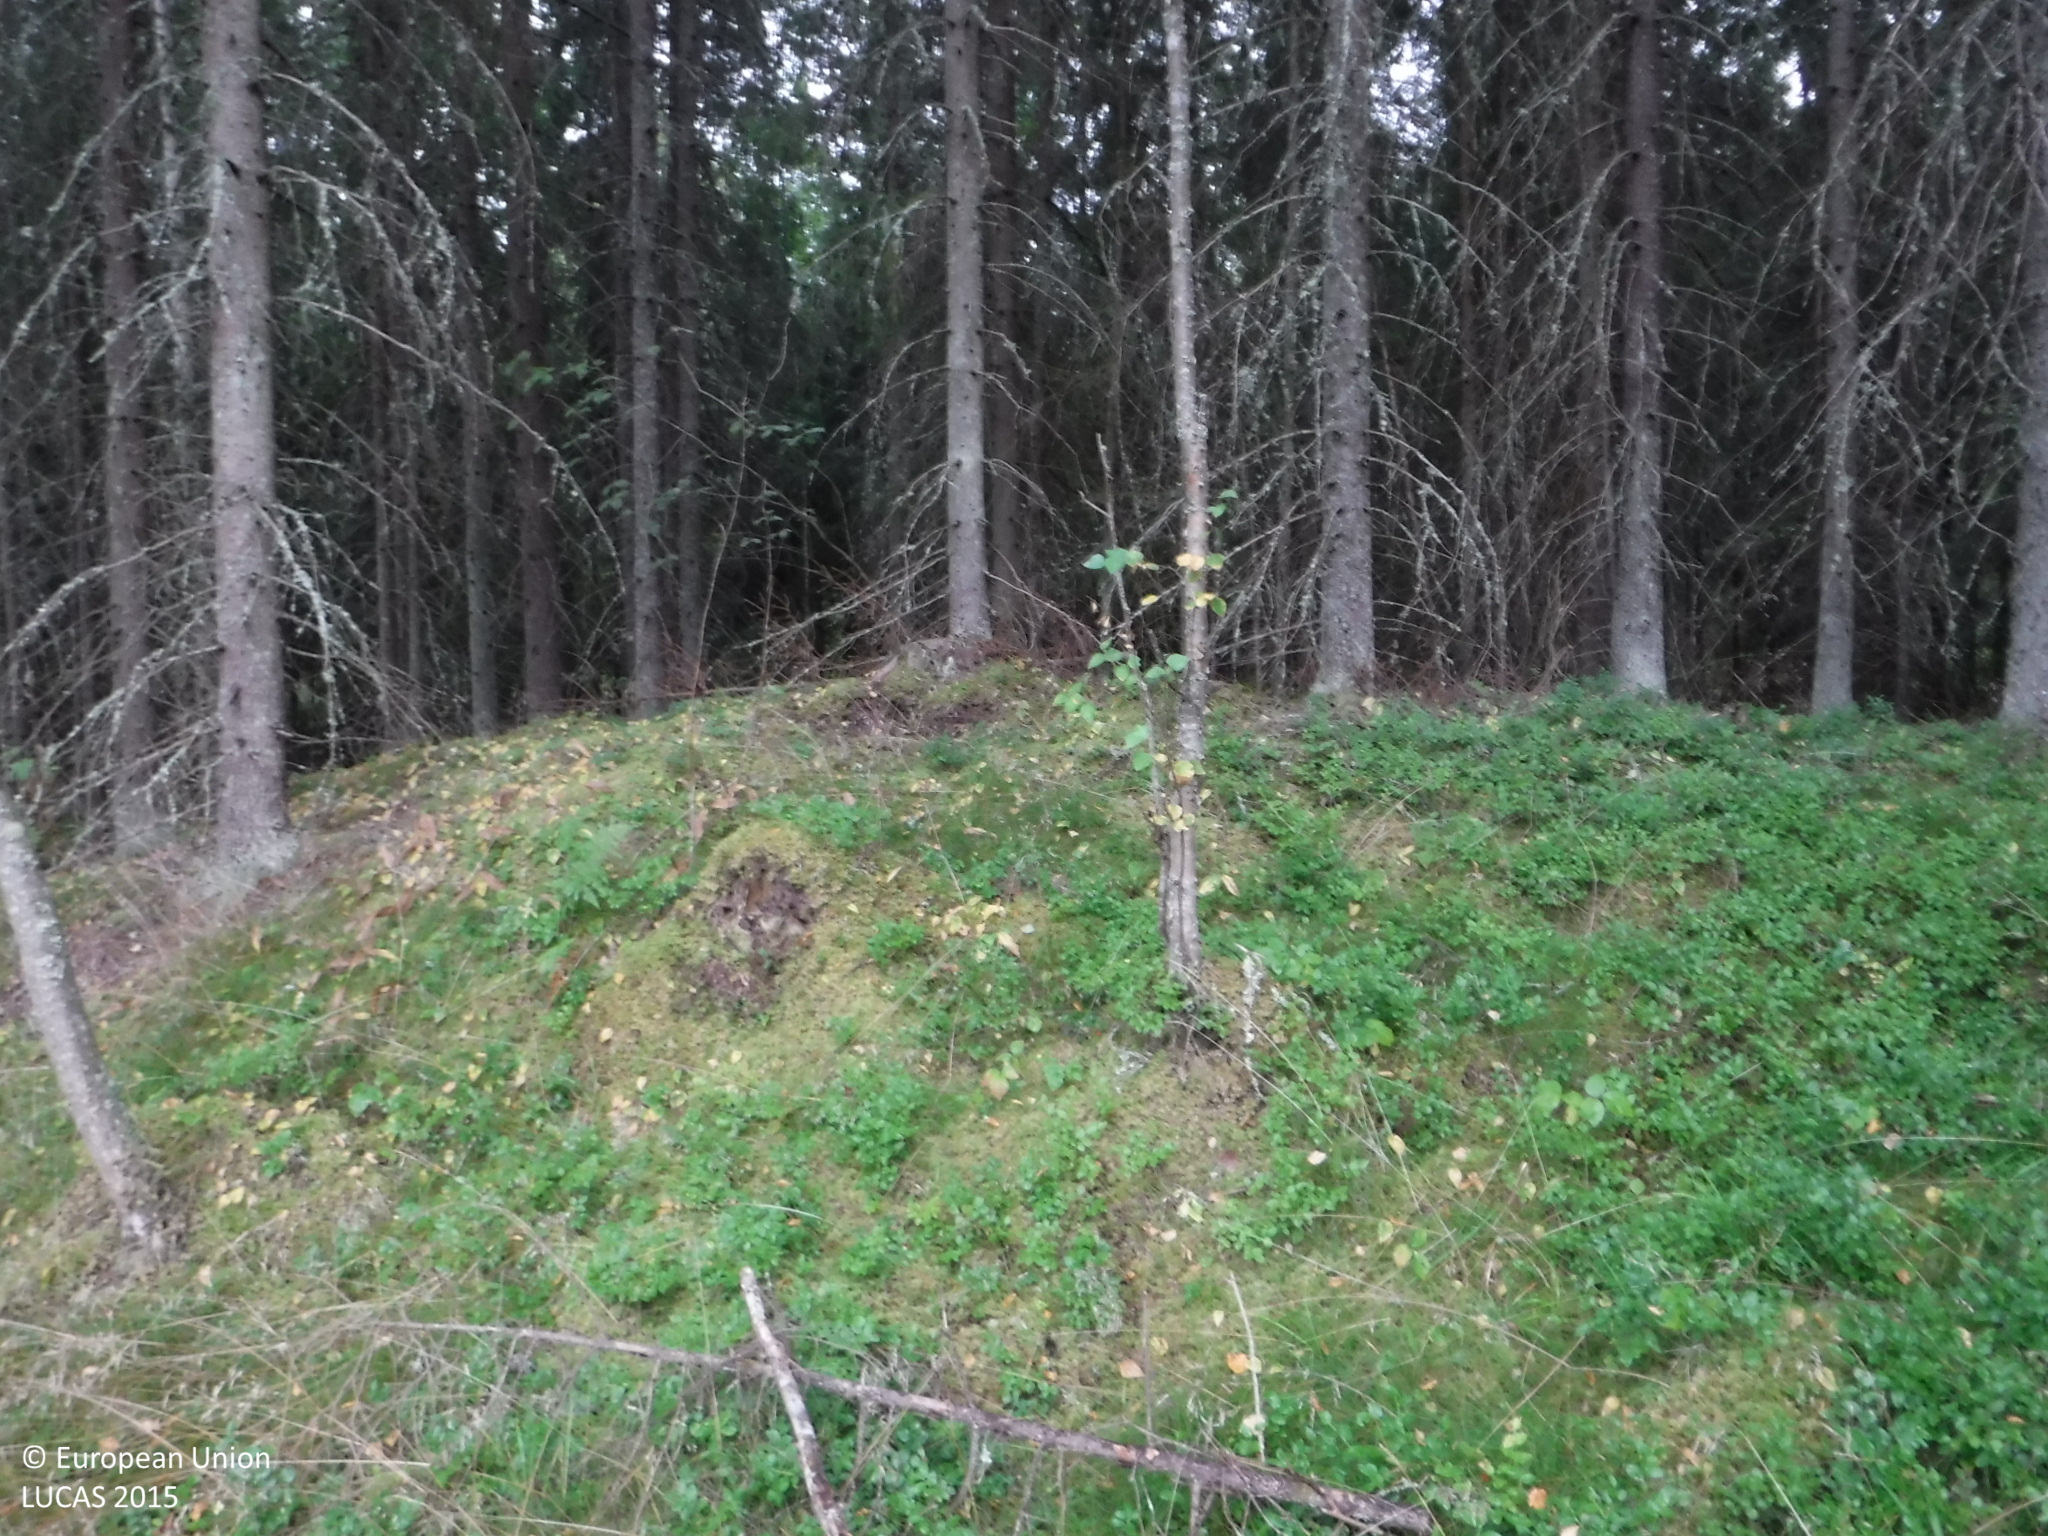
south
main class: Woodland
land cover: Spruce dominated coniferous woodland
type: boreal forest
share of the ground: > 75 %
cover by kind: coniferous forest trees 75 %, lichens and mosses 15 %, broadleaved forest trees 5 %, shrubs 5 %
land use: Forestry
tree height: > 5 m
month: August
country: FI
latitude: 61.2206
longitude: 23.0142
